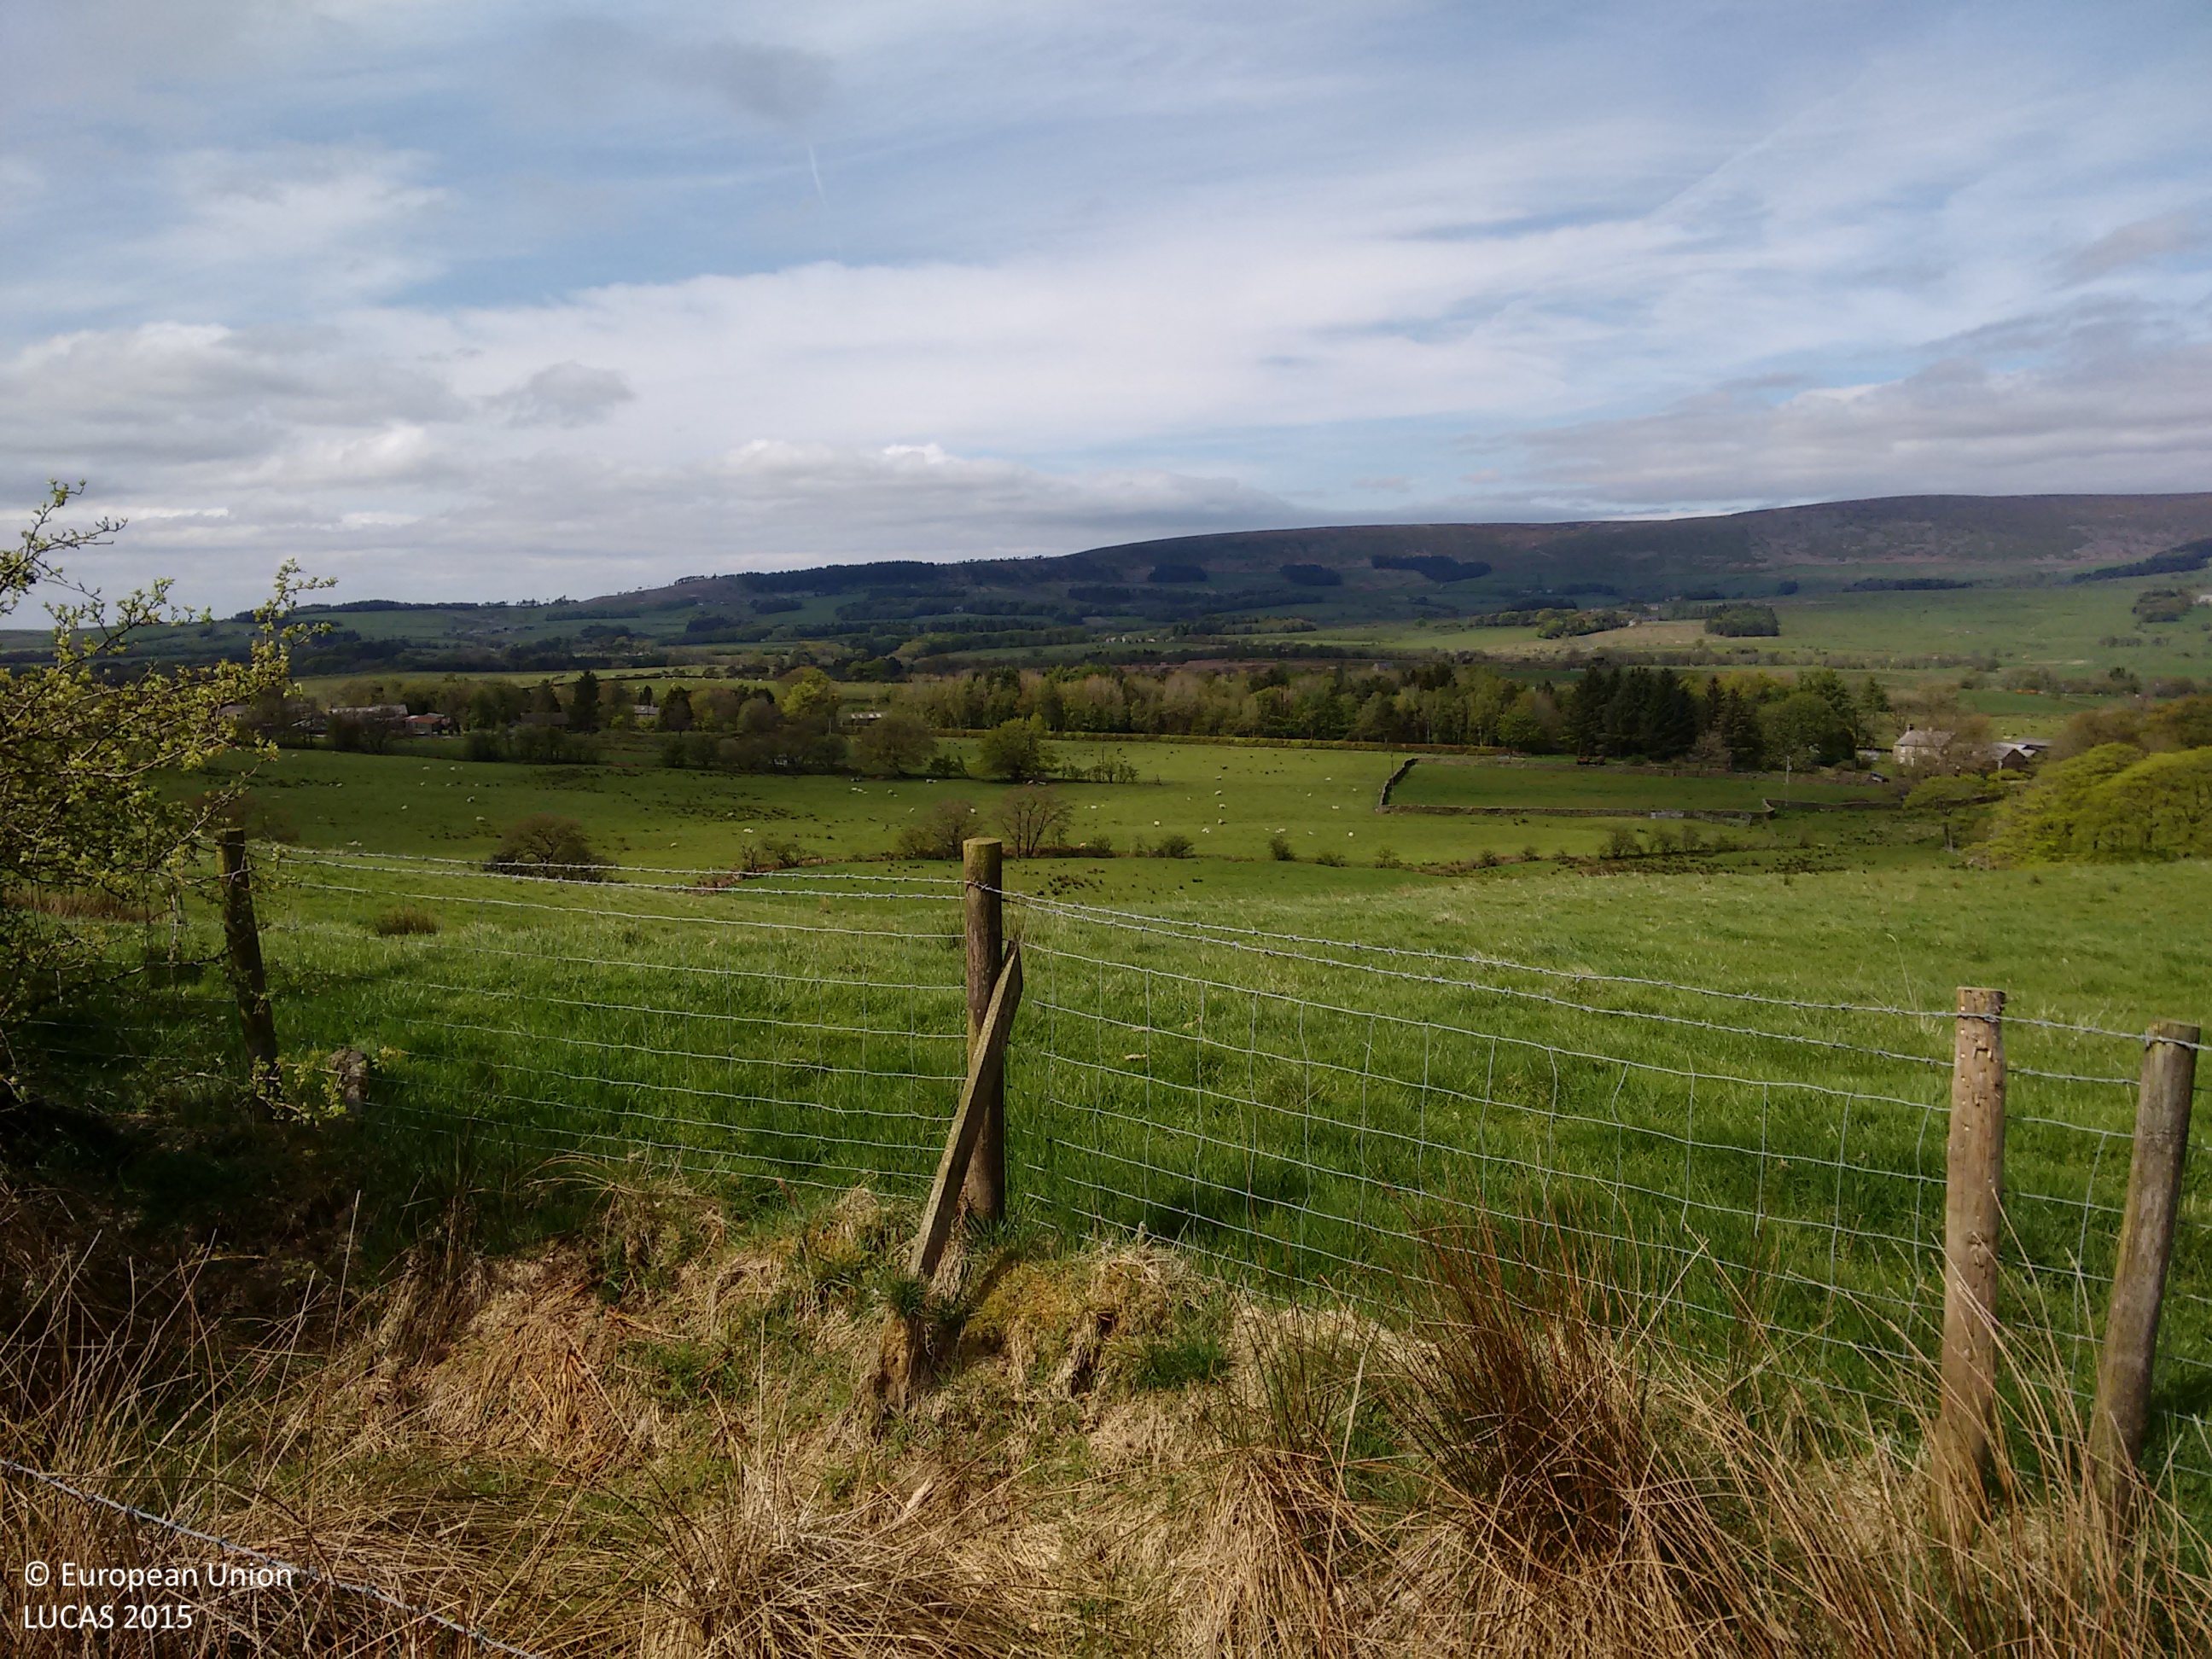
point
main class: Grassland
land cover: Grassland without tree/shrub cover
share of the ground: > 75 %
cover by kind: herbaceous plants 100 %
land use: Agriculture (excluding fallow land and kitchen gardens)
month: May
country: GB
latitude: 53.8826
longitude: -2.6485
